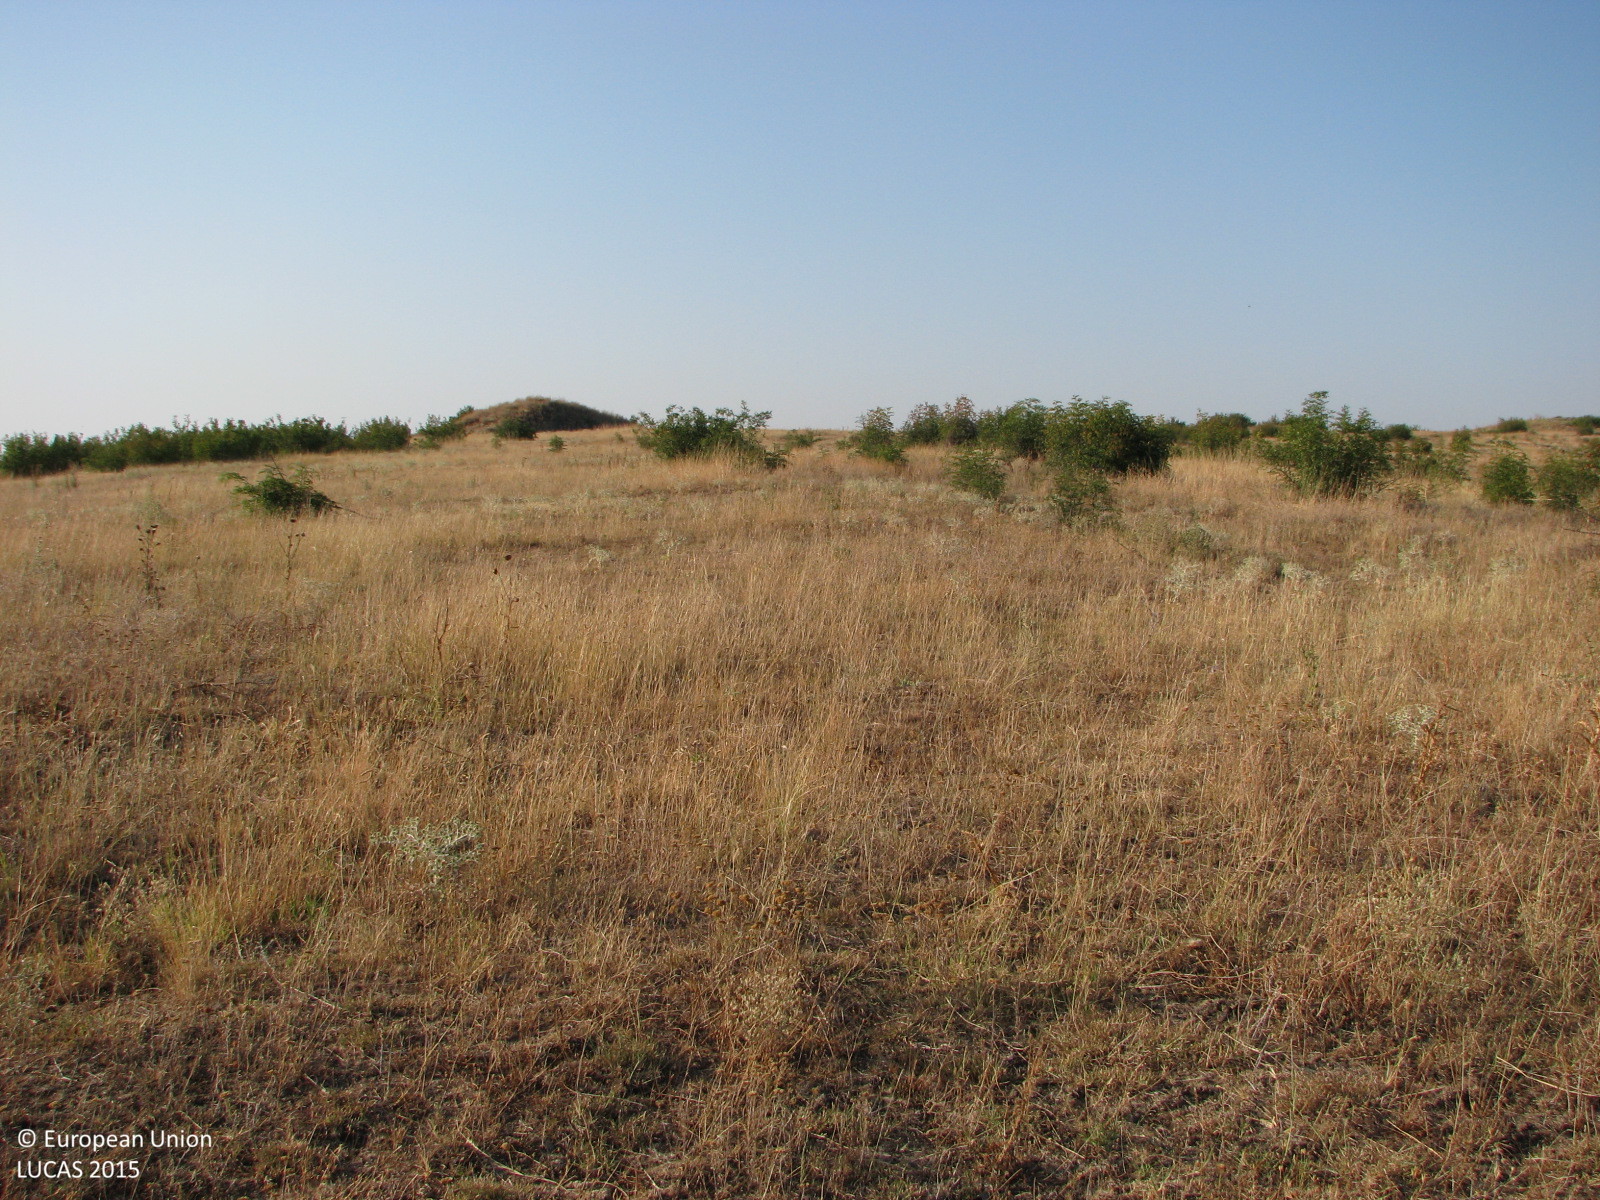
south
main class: Grassland
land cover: Grassland with sparse tree/shrub cover
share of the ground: > 75 %
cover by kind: herbaceous plants 90 %, broadleaved forest trees 5 %, shrubs 5 %
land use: Agriculture (excluding fallow land and kitchen gardens)
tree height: < 5 m
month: August
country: BG
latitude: 42.5142
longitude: 26.4370
